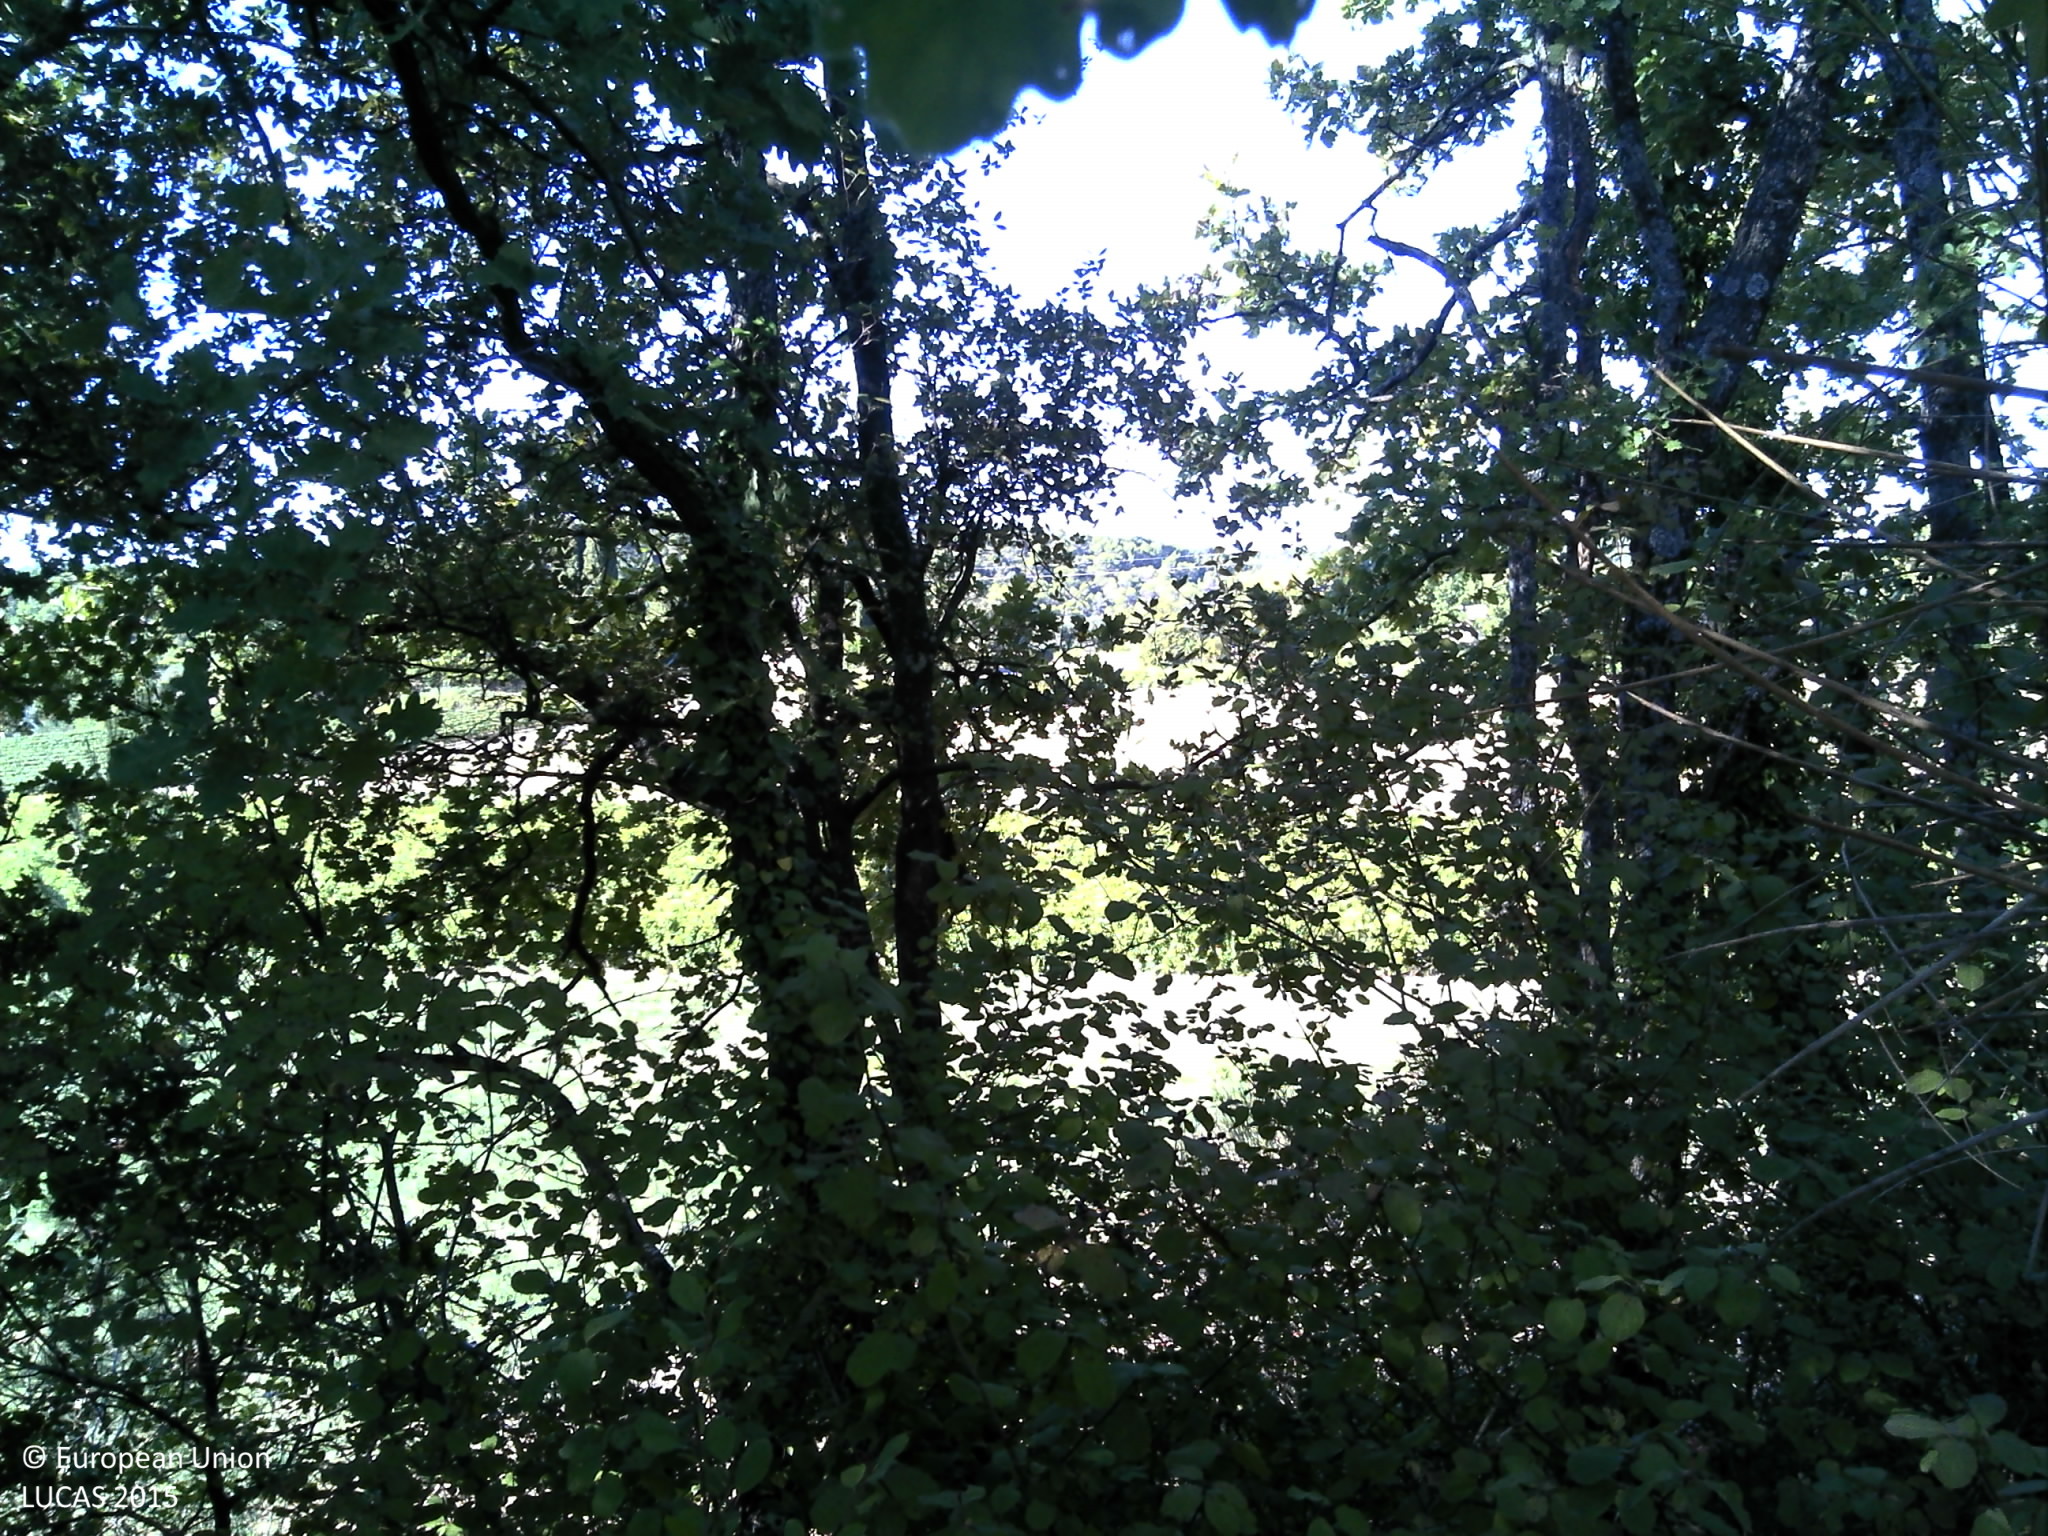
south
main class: Woodland
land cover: Broadleaved woodland
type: thermophilous deciduous forest
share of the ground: 50 - 75 %
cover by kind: broadleaved forest trees 70 %, shrubs 20 %, coniferous forest trees 10 %
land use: Forestry
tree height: > 5 m
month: September
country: FR
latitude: 43.7864
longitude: 5.5726
